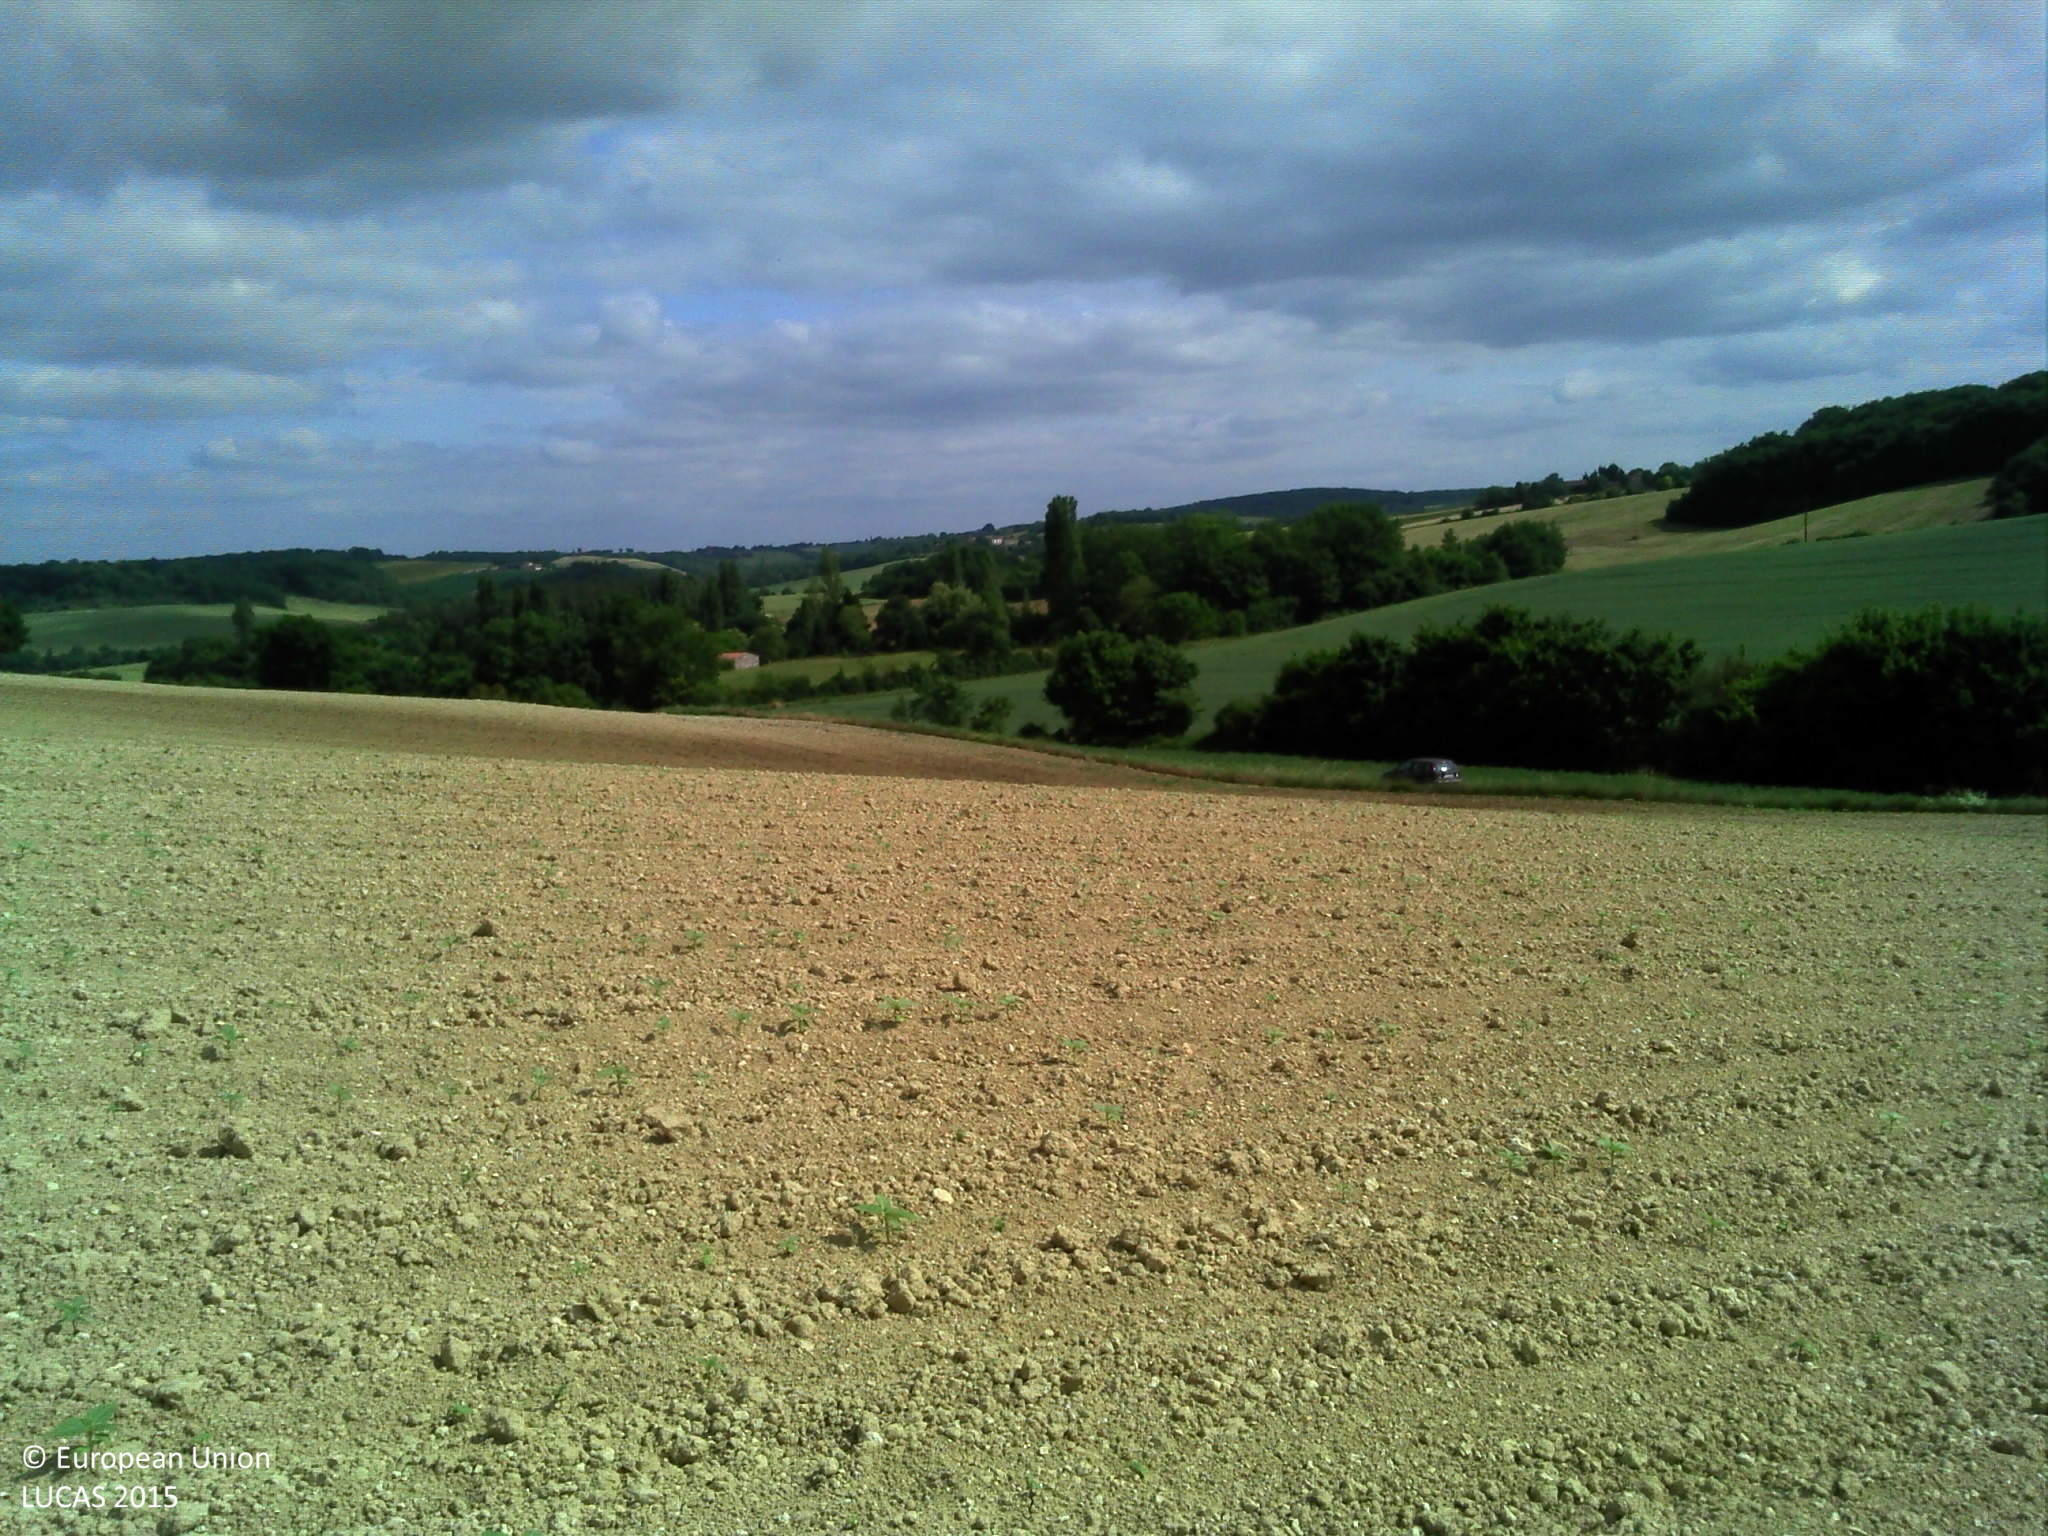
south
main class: Cropland
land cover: Sunflower
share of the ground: < 10 %
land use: Agriculture (excluding fallow land and kitchen gardens)
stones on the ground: < 10 %
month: June
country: FR
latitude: 43.5692
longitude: 0.7003
